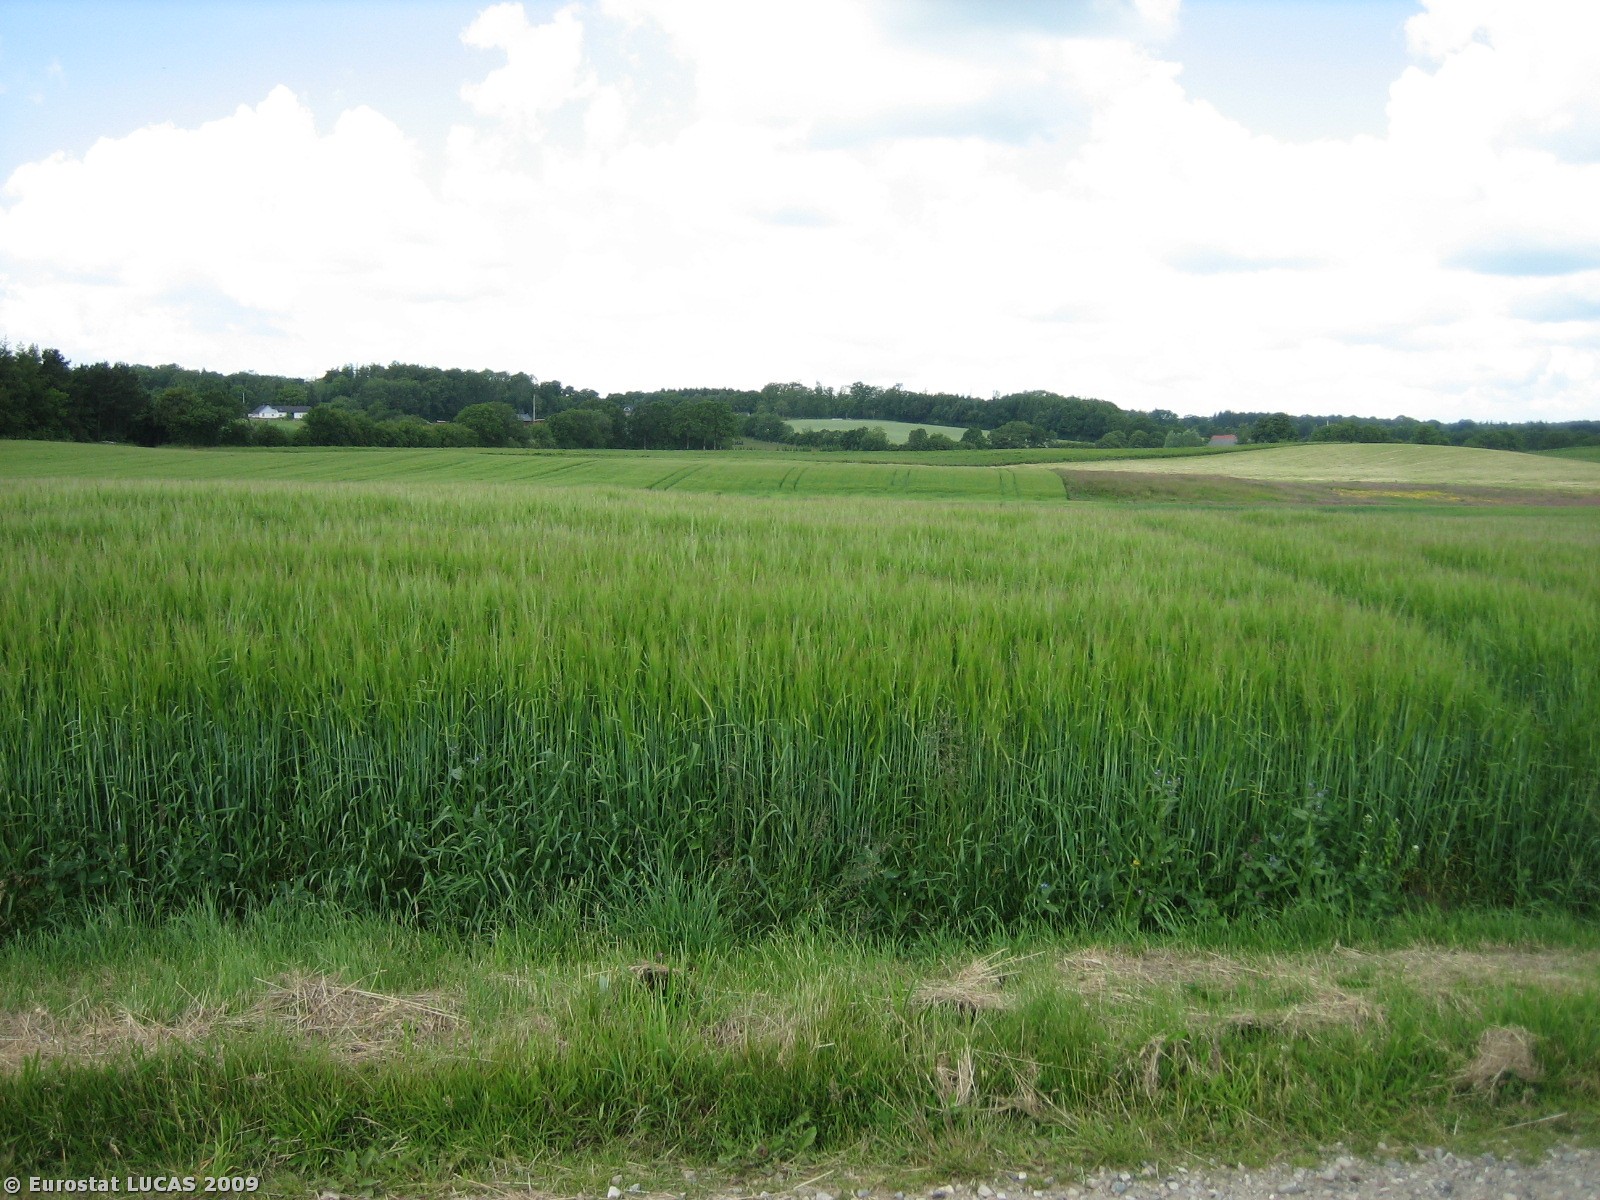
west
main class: Cropland
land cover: Barley
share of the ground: > 75 %
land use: Agriculture (excluding fallow land and kitchen gardens)
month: June
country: DK
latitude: 55.5566
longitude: 9.2873
